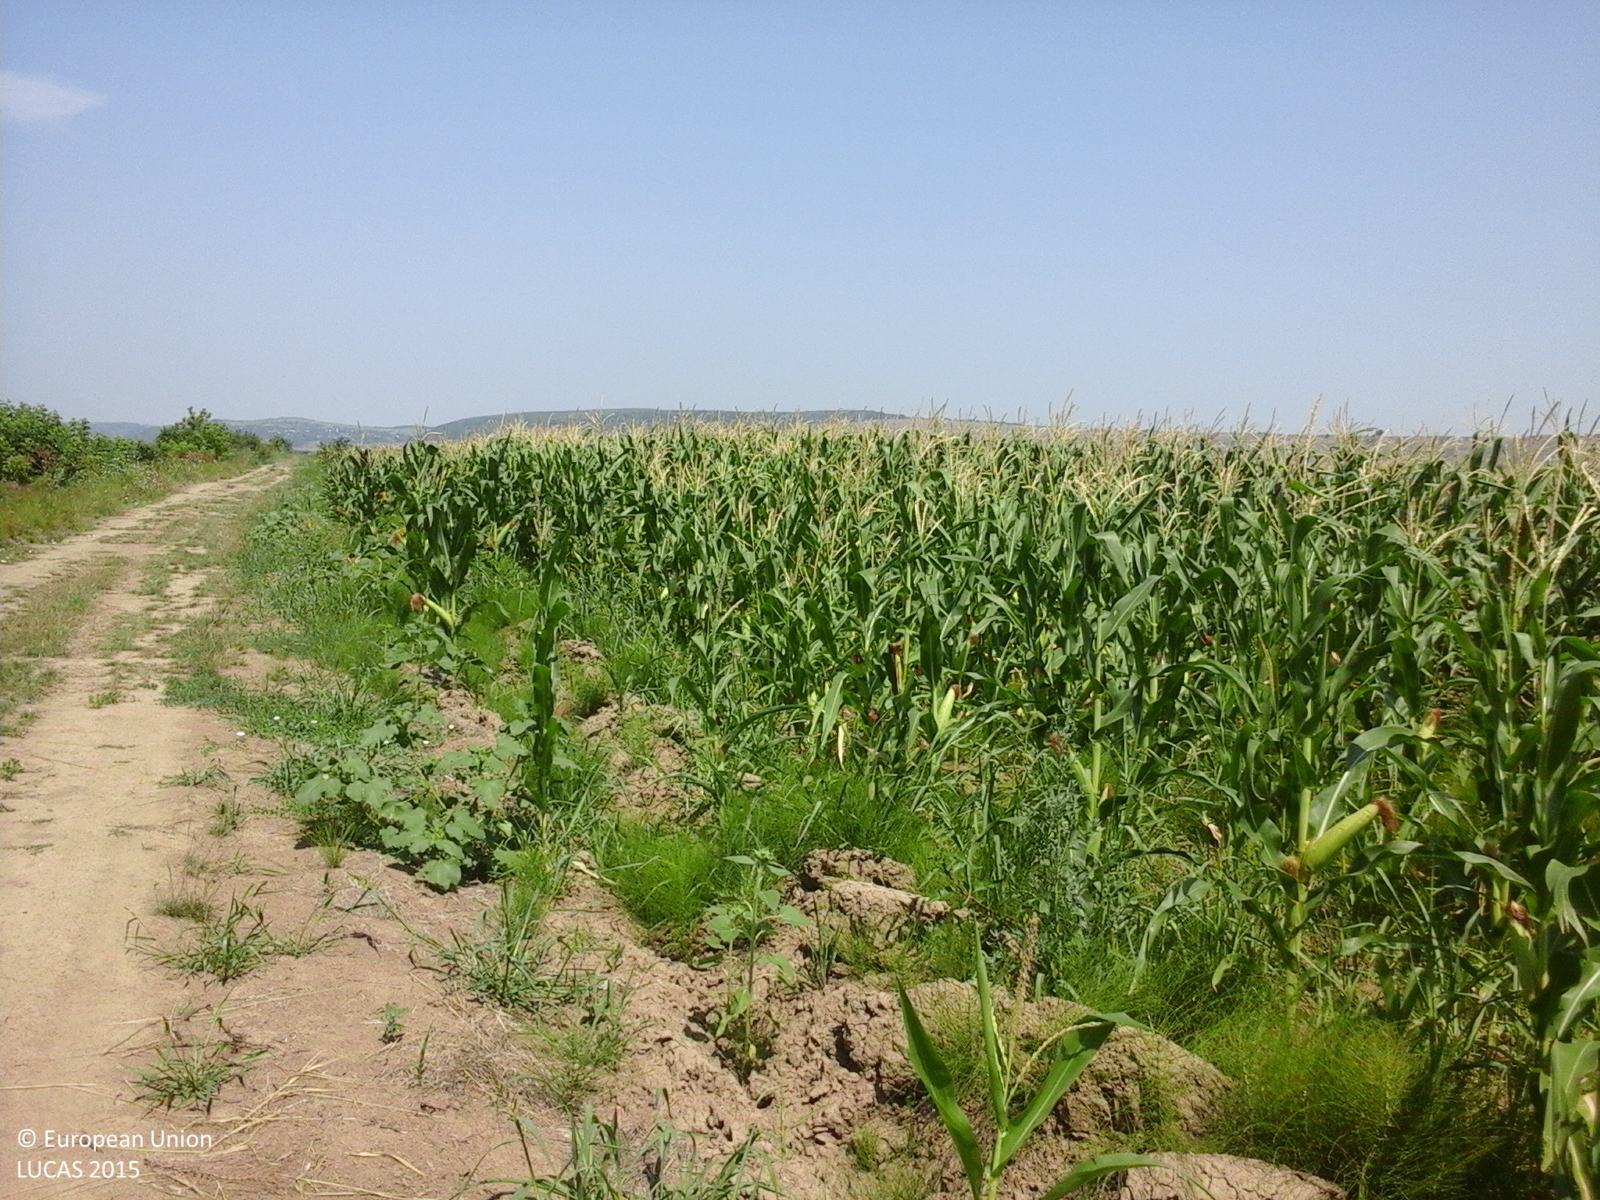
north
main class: Cropland
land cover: Maize
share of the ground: > 75 %
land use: Agriculture (excluding fallow land and kitchen gardens)
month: August
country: RO
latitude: 46.2485
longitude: 27.1014
